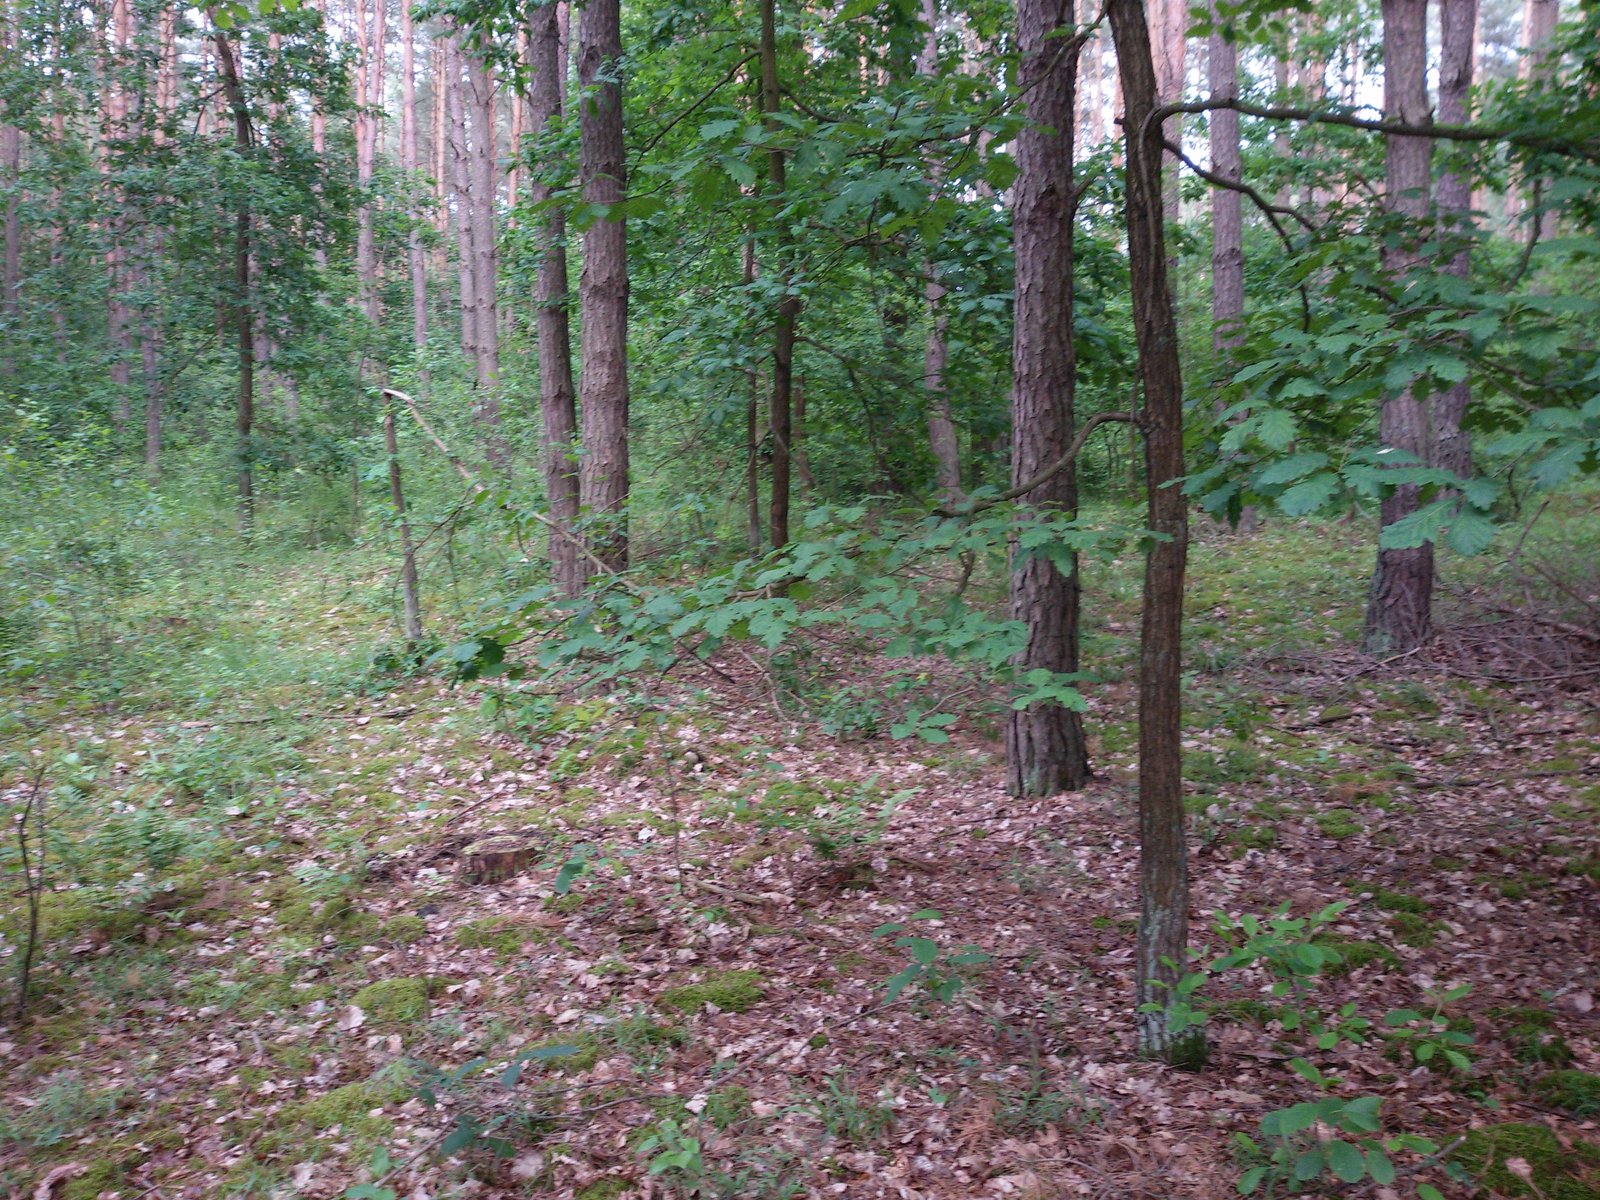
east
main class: Woodland
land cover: Pine dominated coniferous woodland
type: hemiboreal forest and nemoral coniferous forest and mixed broadleaved-coniferous forest
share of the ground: > 75 %
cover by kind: coniferous forest trees 90 %, herbaceous plants 5 %, lichens and mosses 5 %
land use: Forestry
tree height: > 5 m
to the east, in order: Pine dominated coniferous woodland; Tracks; Pine dominated coniferous woodland; Tracks; Pine dominated coniferous woodland
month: September
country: PL
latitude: 51.6277
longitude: 21.0091
